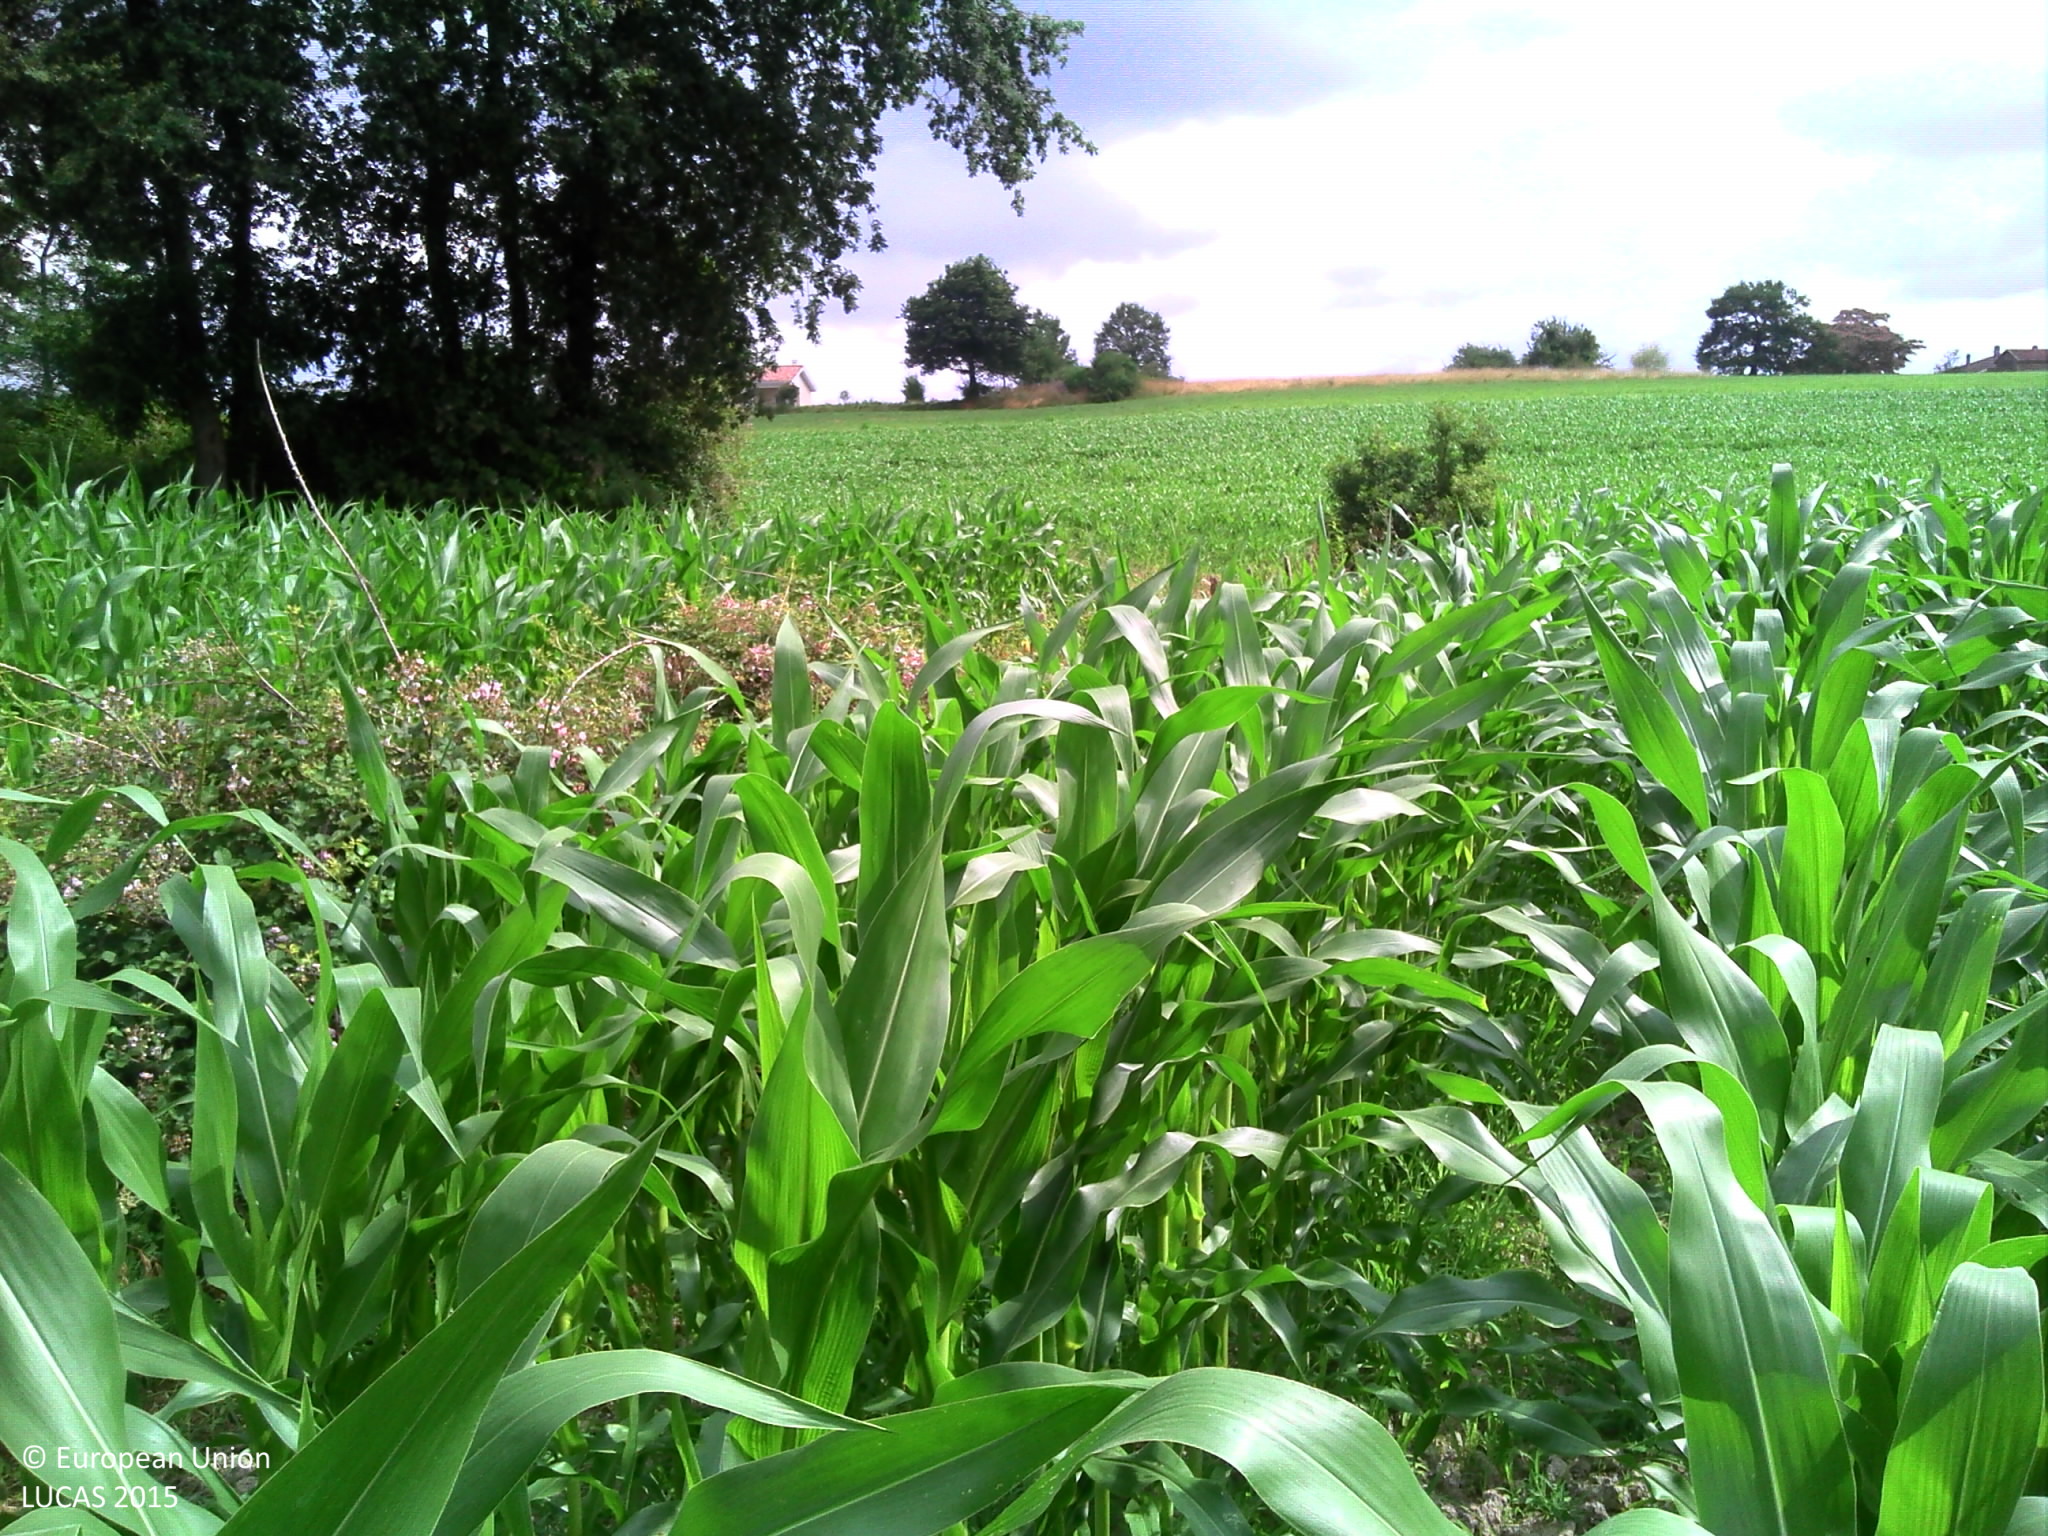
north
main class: Cropland
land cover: Maize
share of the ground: > 75 %
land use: Agriculture (excluding fallow land and kitchen gardens)
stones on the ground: < 10 %
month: July
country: FR
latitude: 43.5598
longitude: -0.6950
